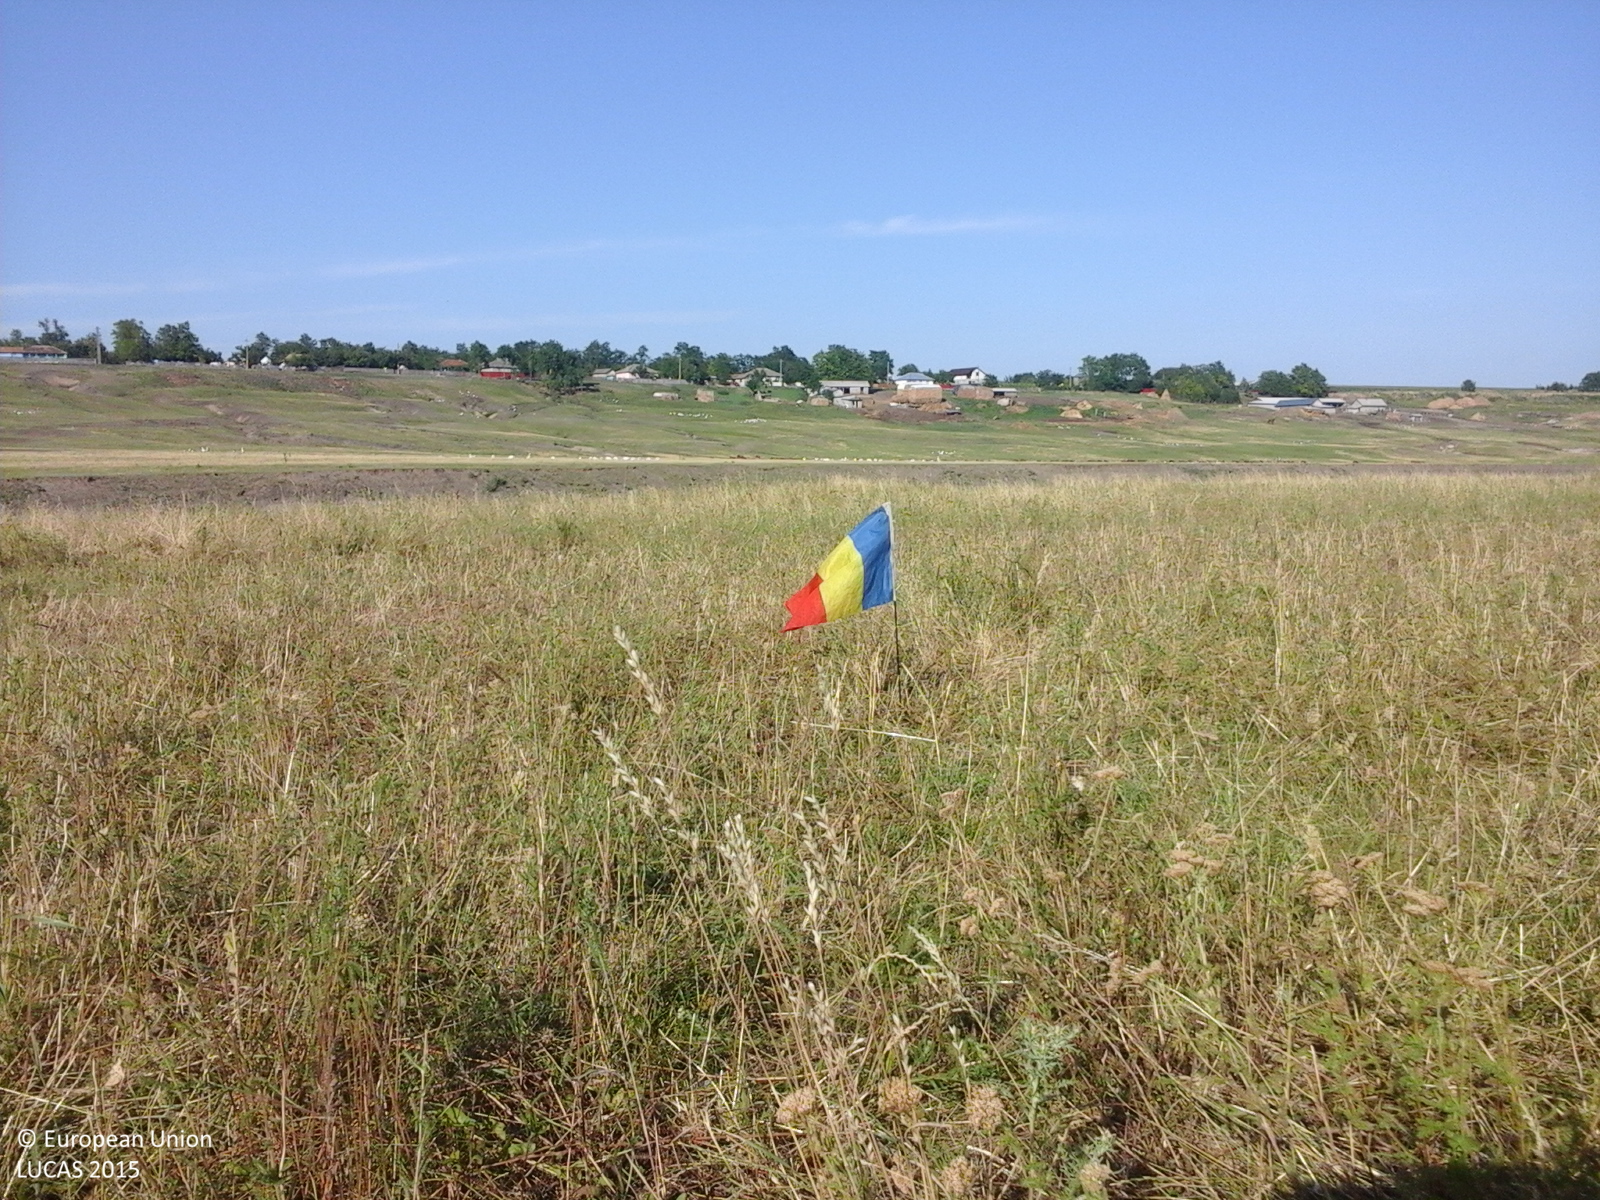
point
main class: Grassland
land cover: Grassland without tree/shrub cover
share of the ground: > 75 %
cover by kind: herbaceous plants 100 %
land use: Agriculture (excluding fallow land and kitchen gardens)
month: June
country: RO
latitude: 47.5981
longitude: 27.1728
